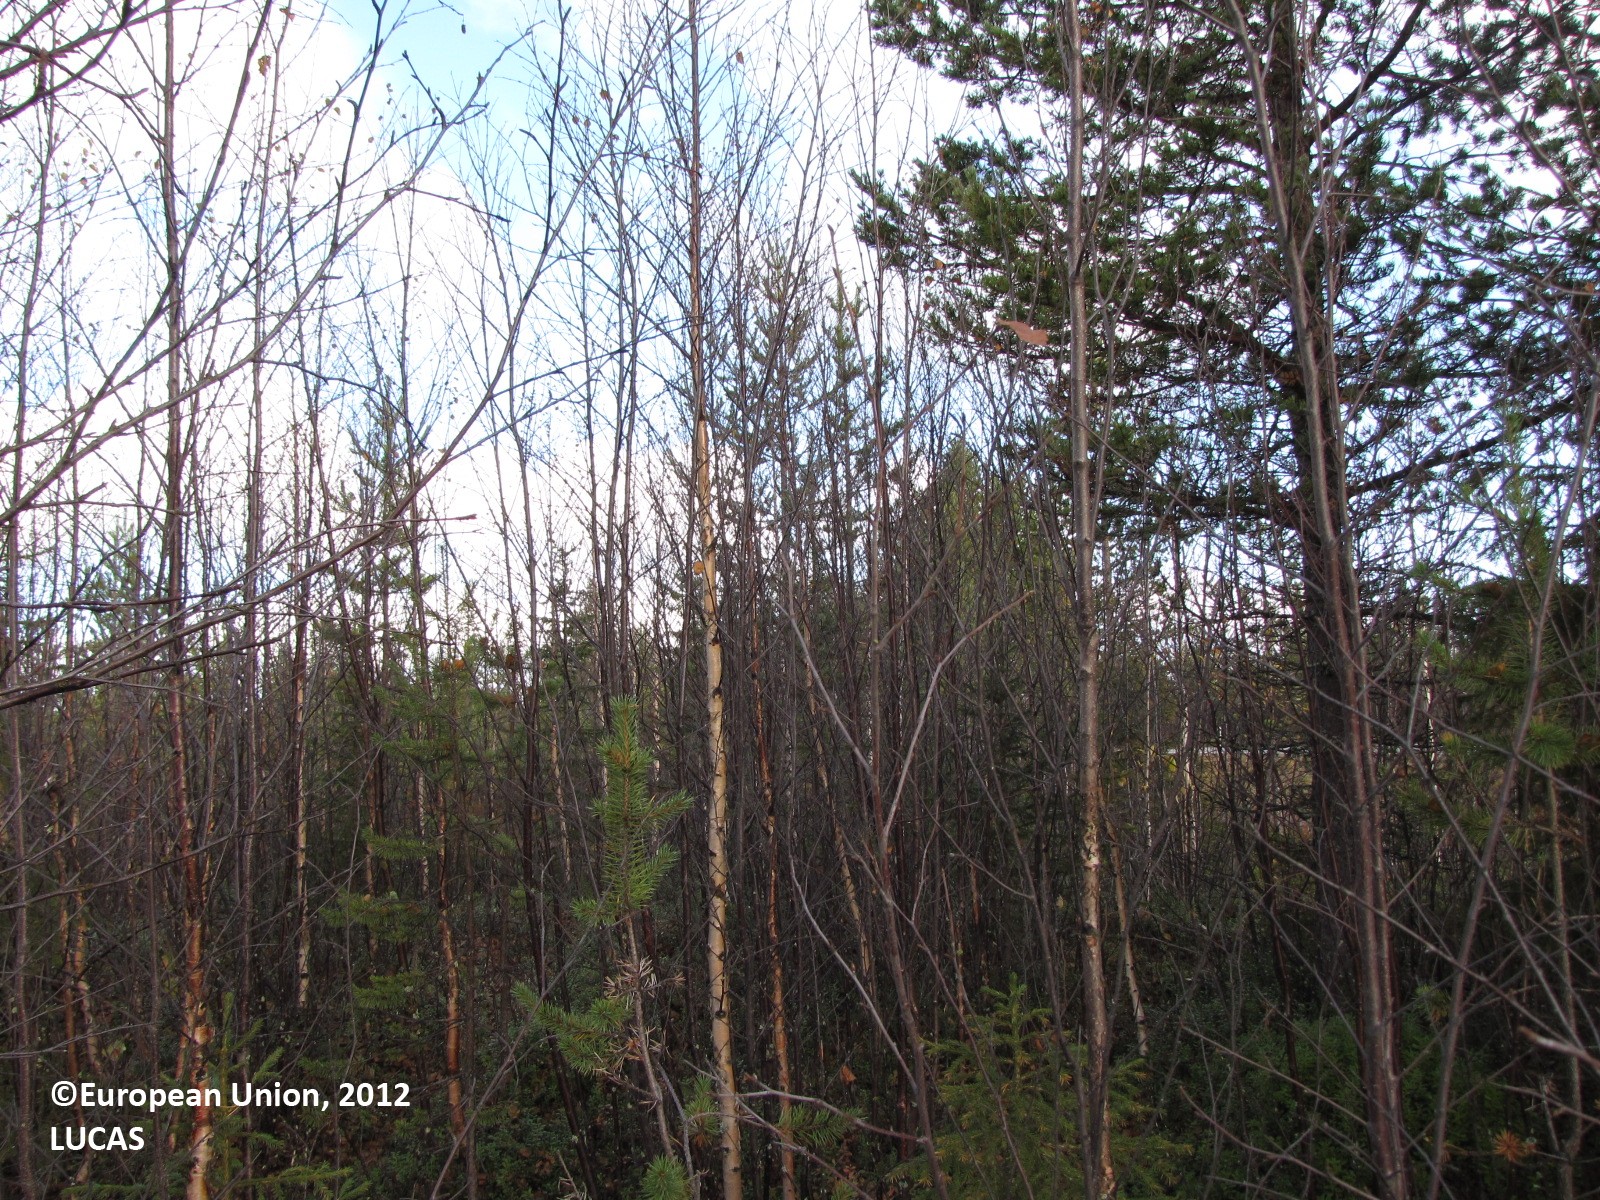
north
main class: Woodland
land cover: Pine dominated mixed woodland
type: boreal forest
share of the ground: 25 - 50 %
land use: Forestry
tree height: > 5 m
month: September
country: FI
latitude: 67.8032
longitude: 23.6525
